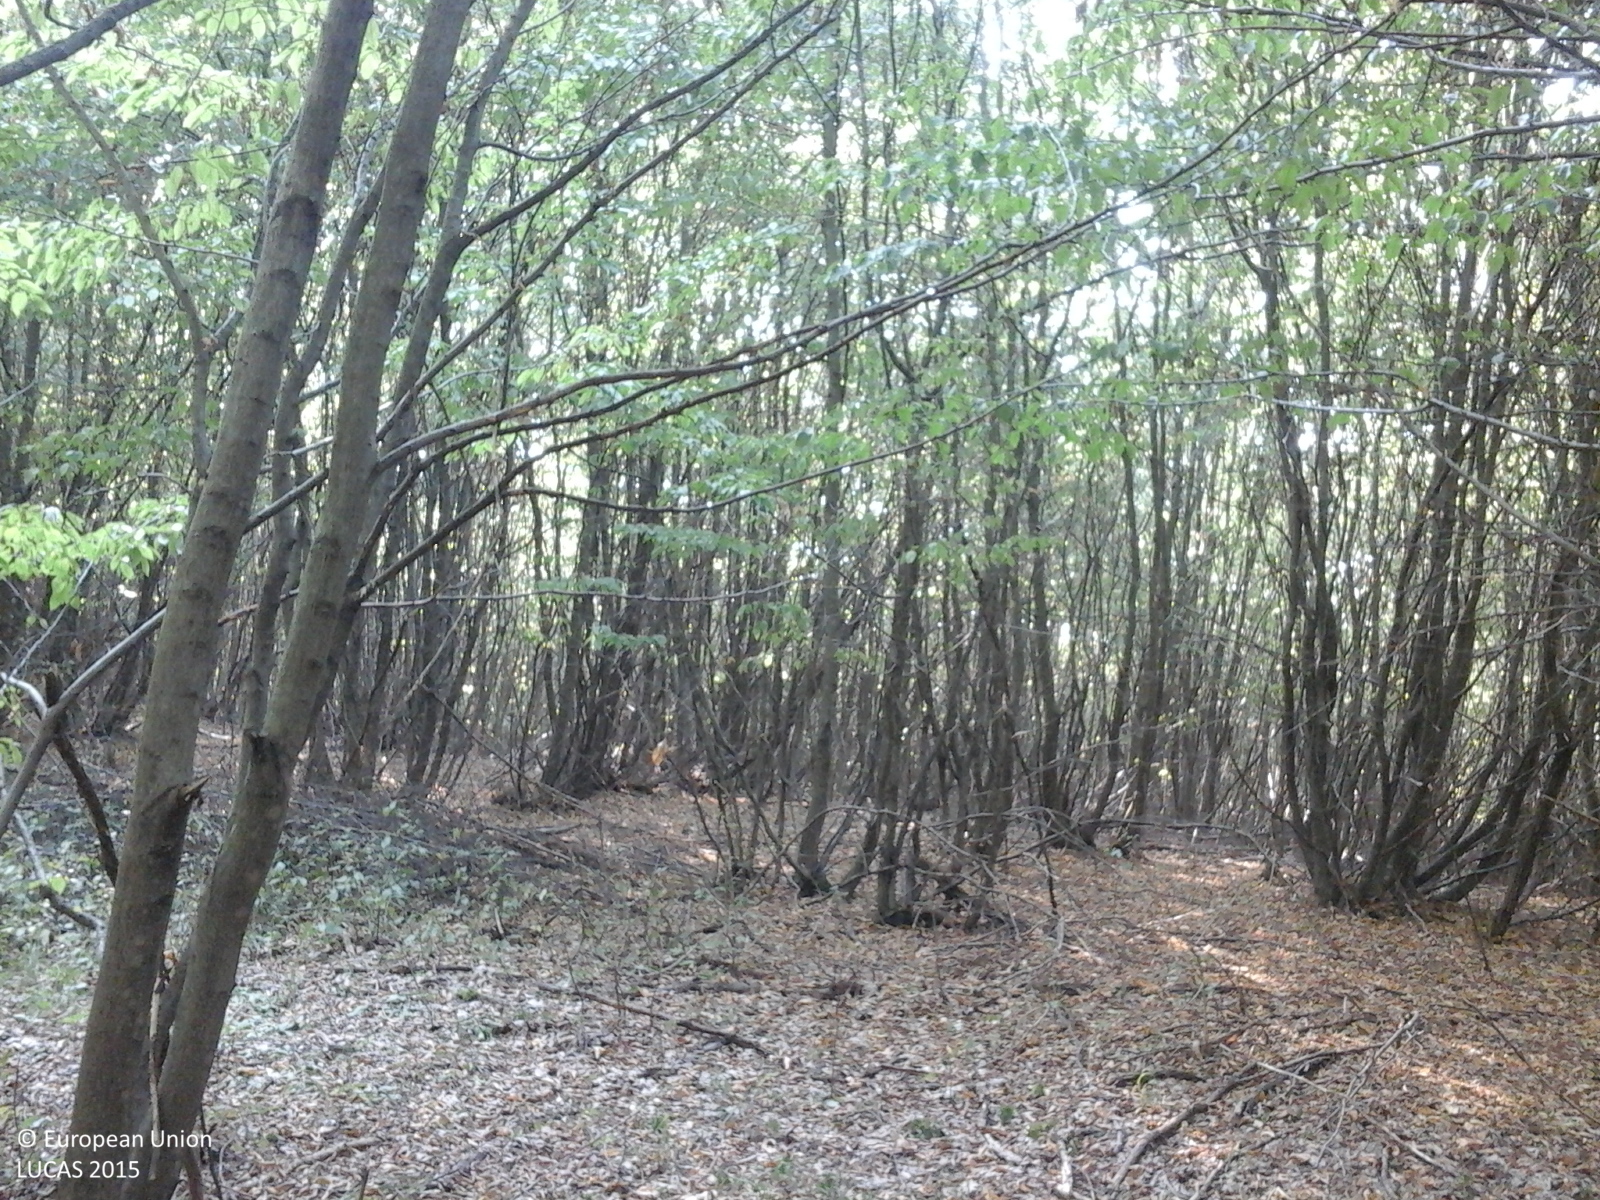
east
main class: Woodland
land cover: Broadleaved woodland
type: beech forest
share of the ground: > 75 %
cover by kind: broadleaved forest trees 100 %
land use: Forestry
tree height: > 5 m
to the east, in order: Broadleaved woodland; Grassland with sparse tree/shrub cover
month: September
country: RO
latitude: 46.8803
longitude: 24.4570
